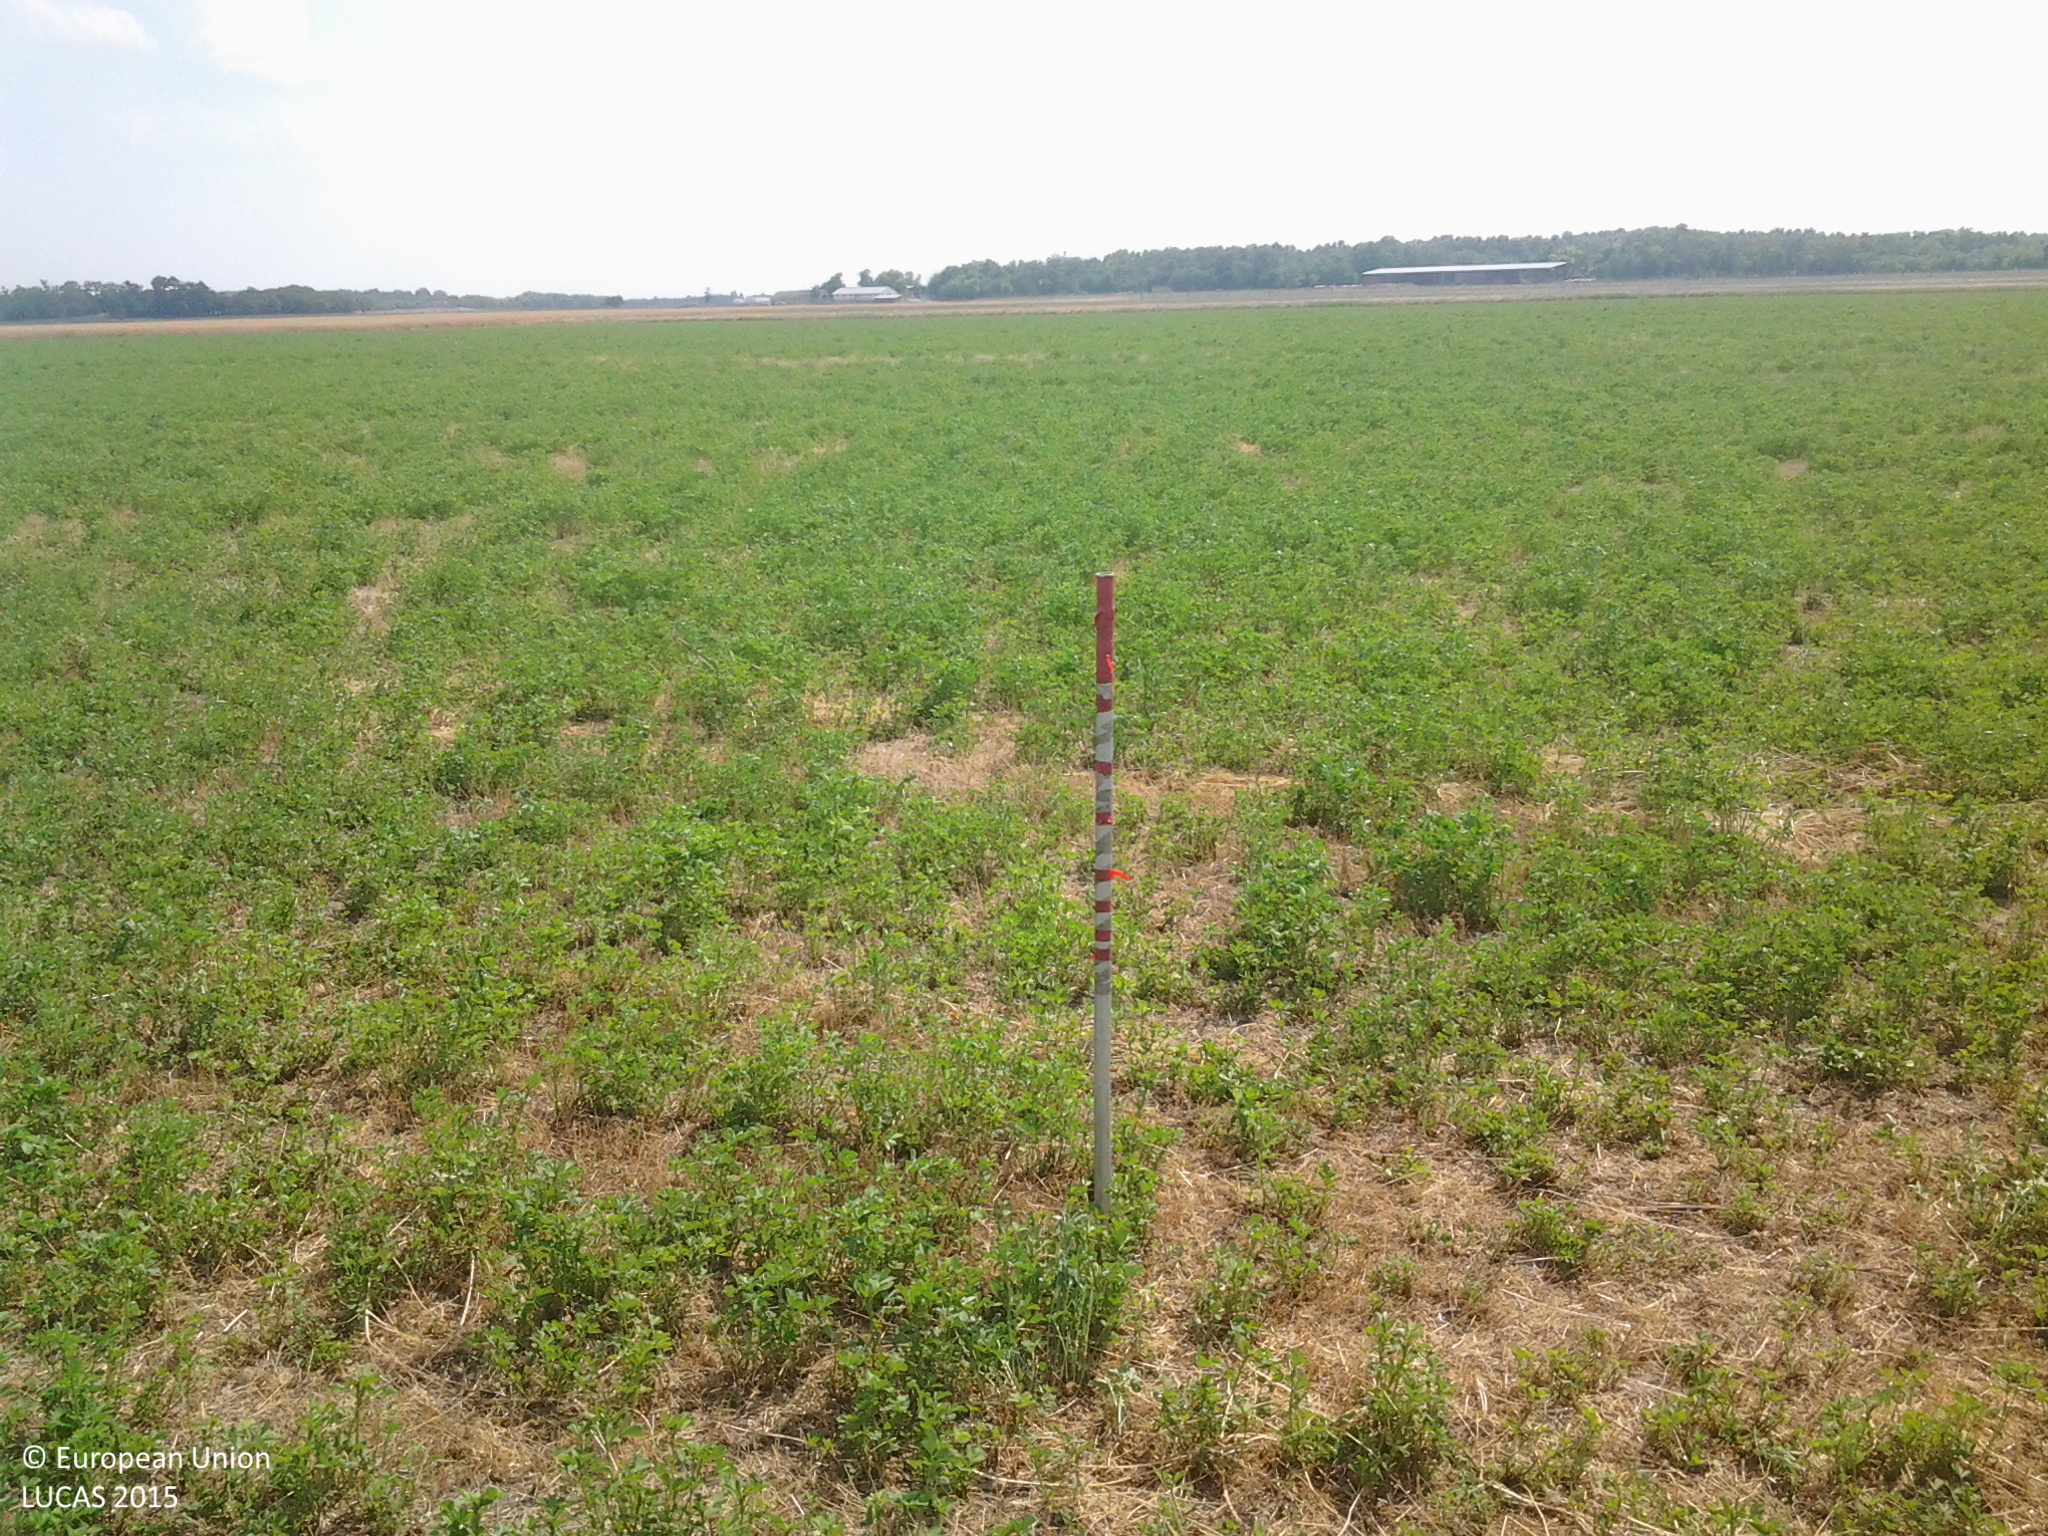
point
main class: Cropland
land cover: Lucerne
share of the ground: > 75 %
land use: Agriculture (excluding fallow land and kitchen gardens)
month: July
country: HU
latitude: 47.0553
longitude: 19.2461
